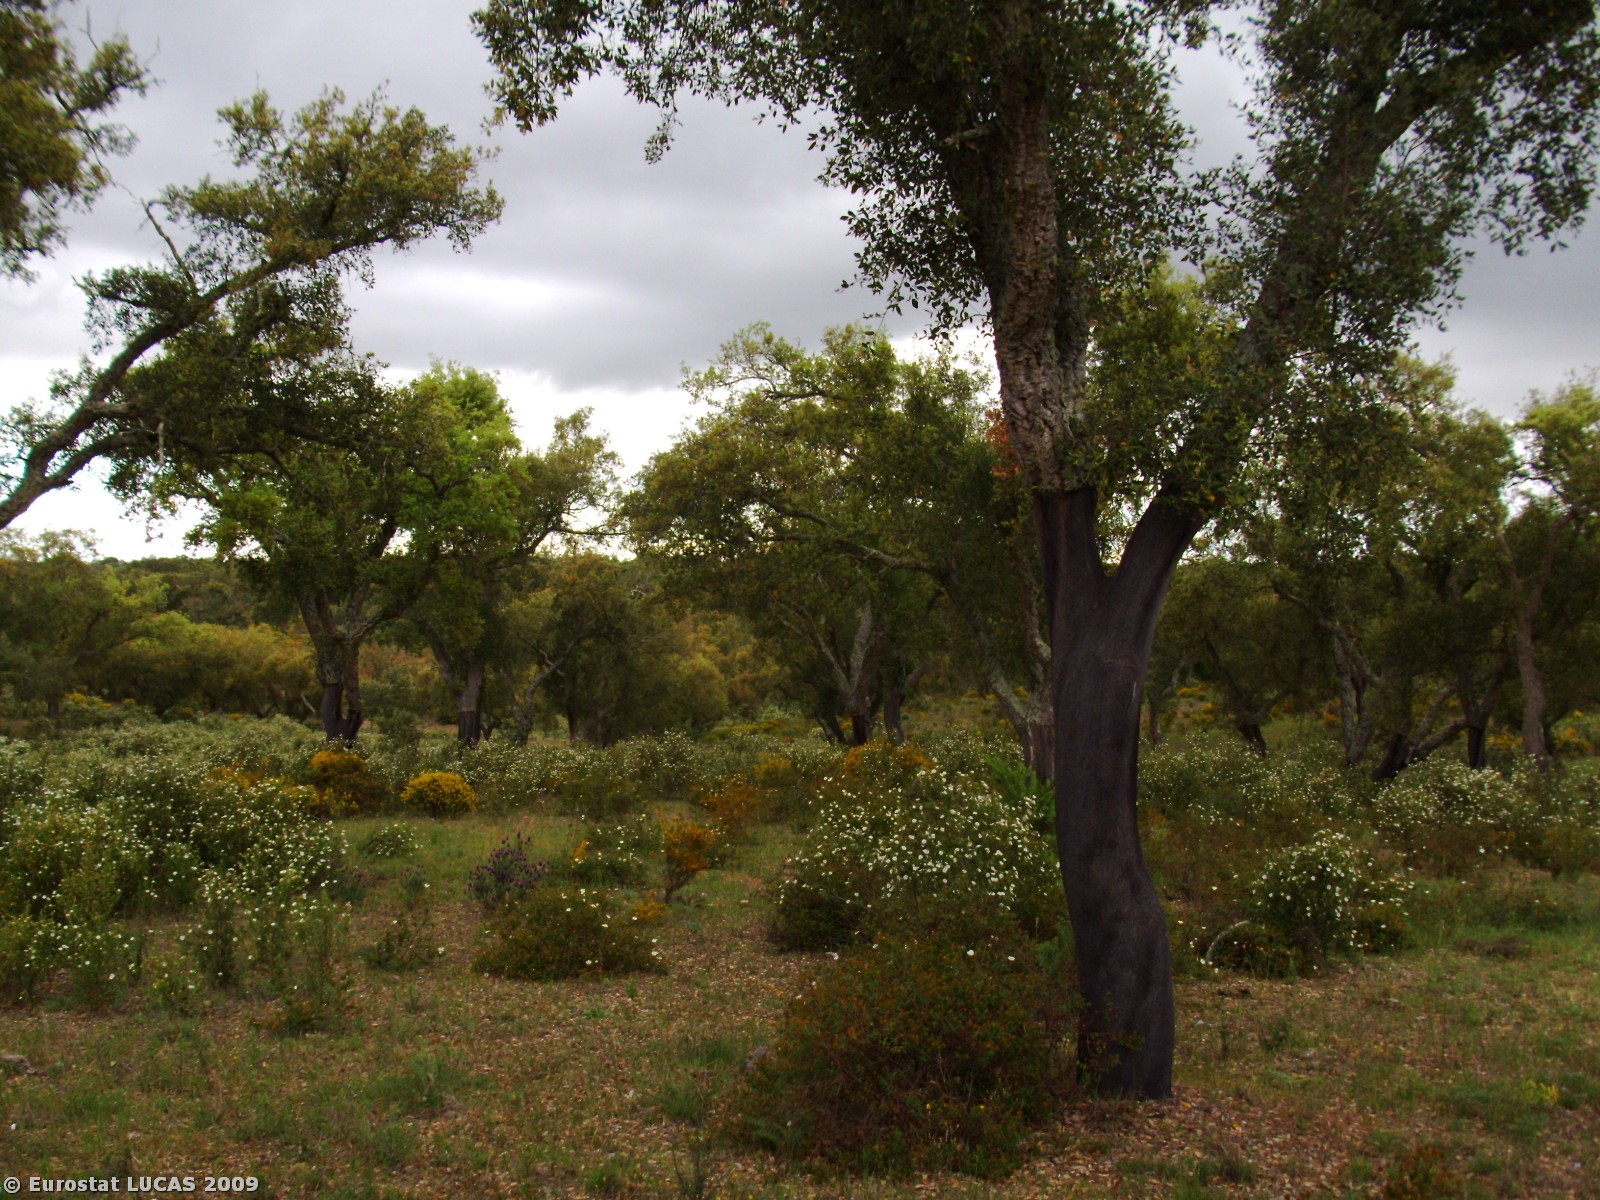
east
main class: Woodland
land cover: Broadleaved woodland
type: broadleaved evergreen forest
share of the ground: 25 - 50 %
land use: Forestry
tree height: > 5 m
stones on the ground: 25 - 50 %
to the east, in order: Broadleaved woodland; Spontaneously vegetated surfaces; Broadleaved woodland
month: April
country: PT
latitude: 38.5305
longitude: -7.7112
